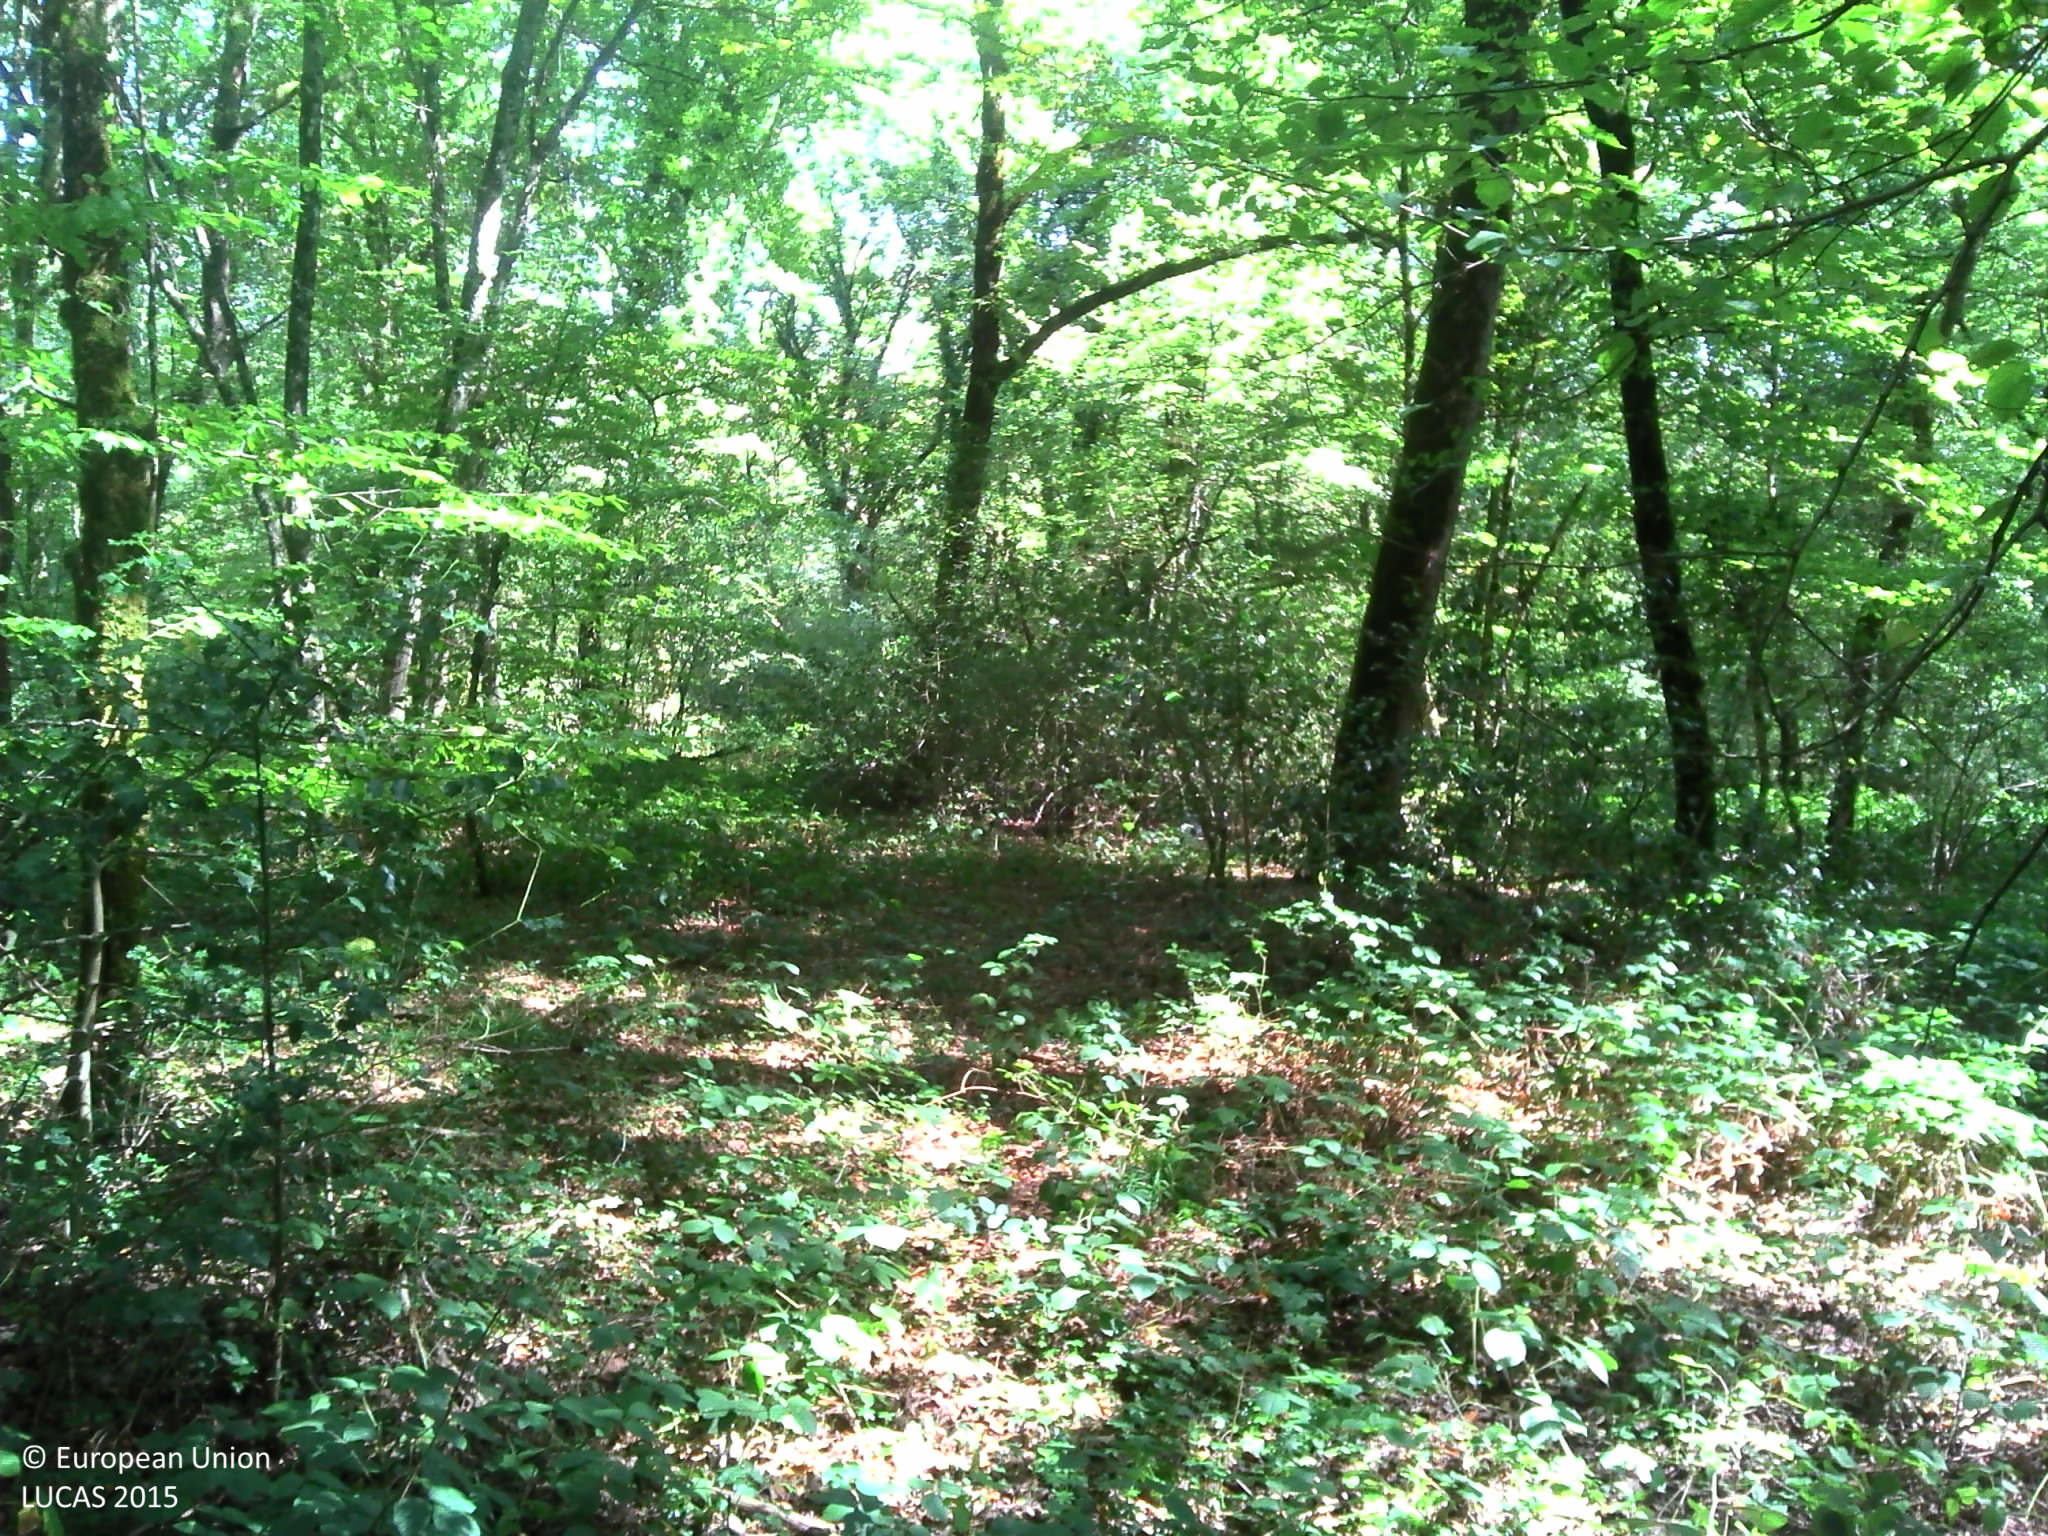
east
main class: Woodland
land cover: Broadleaved woodland
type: mesophytic deciduous forest
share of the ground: > 75 %
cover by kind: broadleaved forest trees 100 %
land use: Forestry
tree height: > 5 m
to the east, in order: Broadleaved woodland; Tracks; Broadleaved woodland; Tracks; Broadleaved woodland; Tracks; Broadleaved woodland
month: September
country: FR
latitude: 47.4049
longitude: 6.3045
